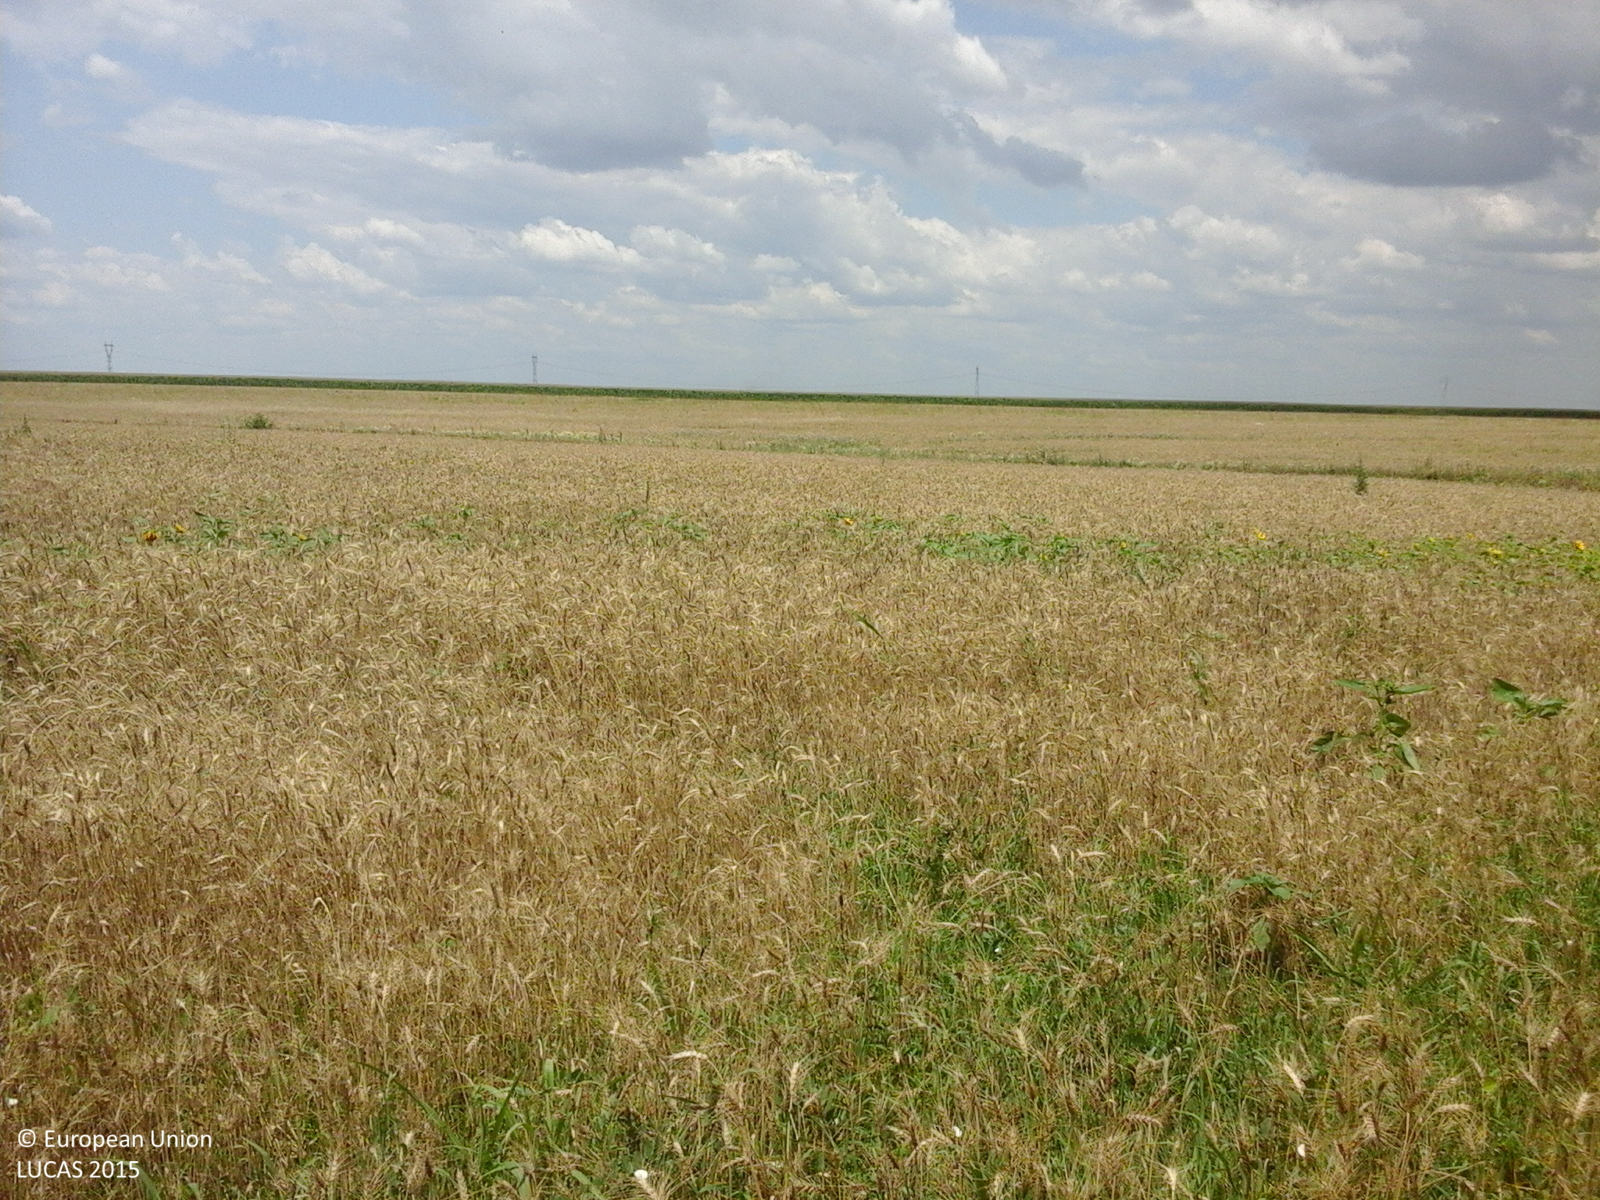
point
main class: Cropland
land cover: Common wheat
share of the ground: > 75 %
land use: Agriculture (excluding fallow land and kitchen gardens)
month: July
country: RO
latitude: 43.8613
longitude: 25.2213
